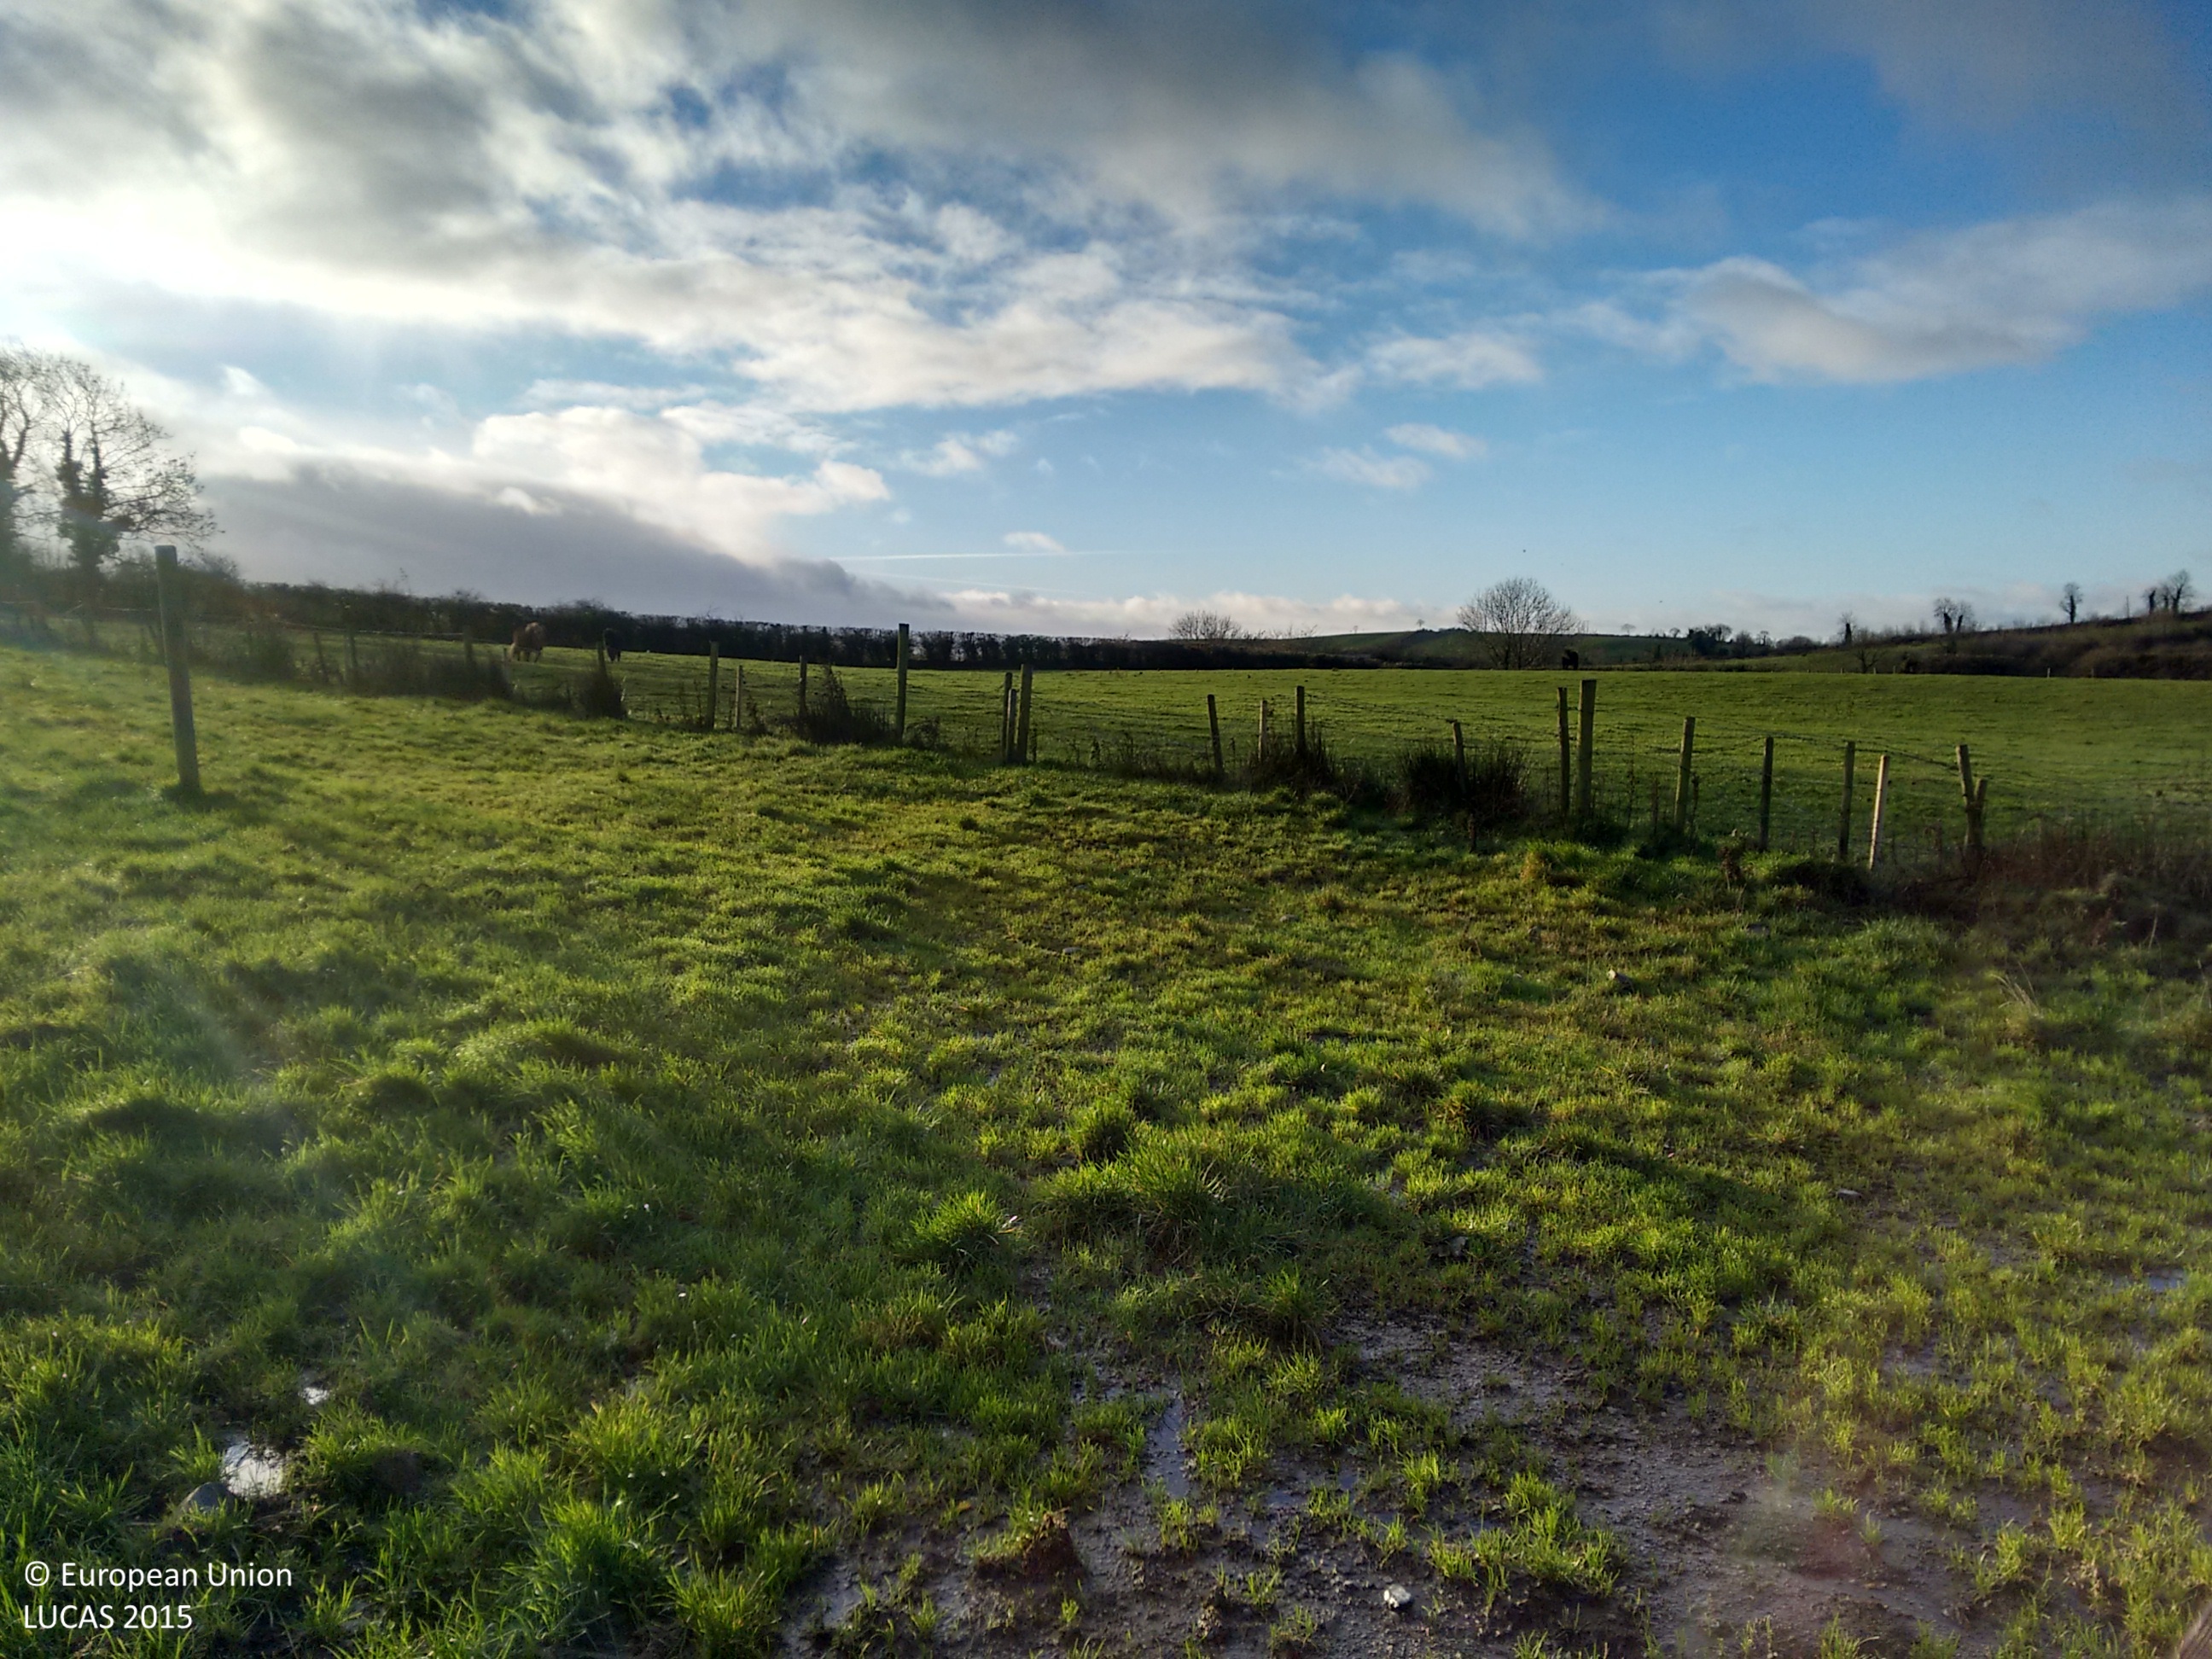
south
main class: Grassland
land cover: Grassland without tree/shrub cover
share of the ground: > 75 %
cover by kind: herbaceous plants 100 %
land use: Agriculture (excluding fallow land and kitchen gardens)
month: December
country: IE
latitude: 54.0287
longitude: -6.7267
